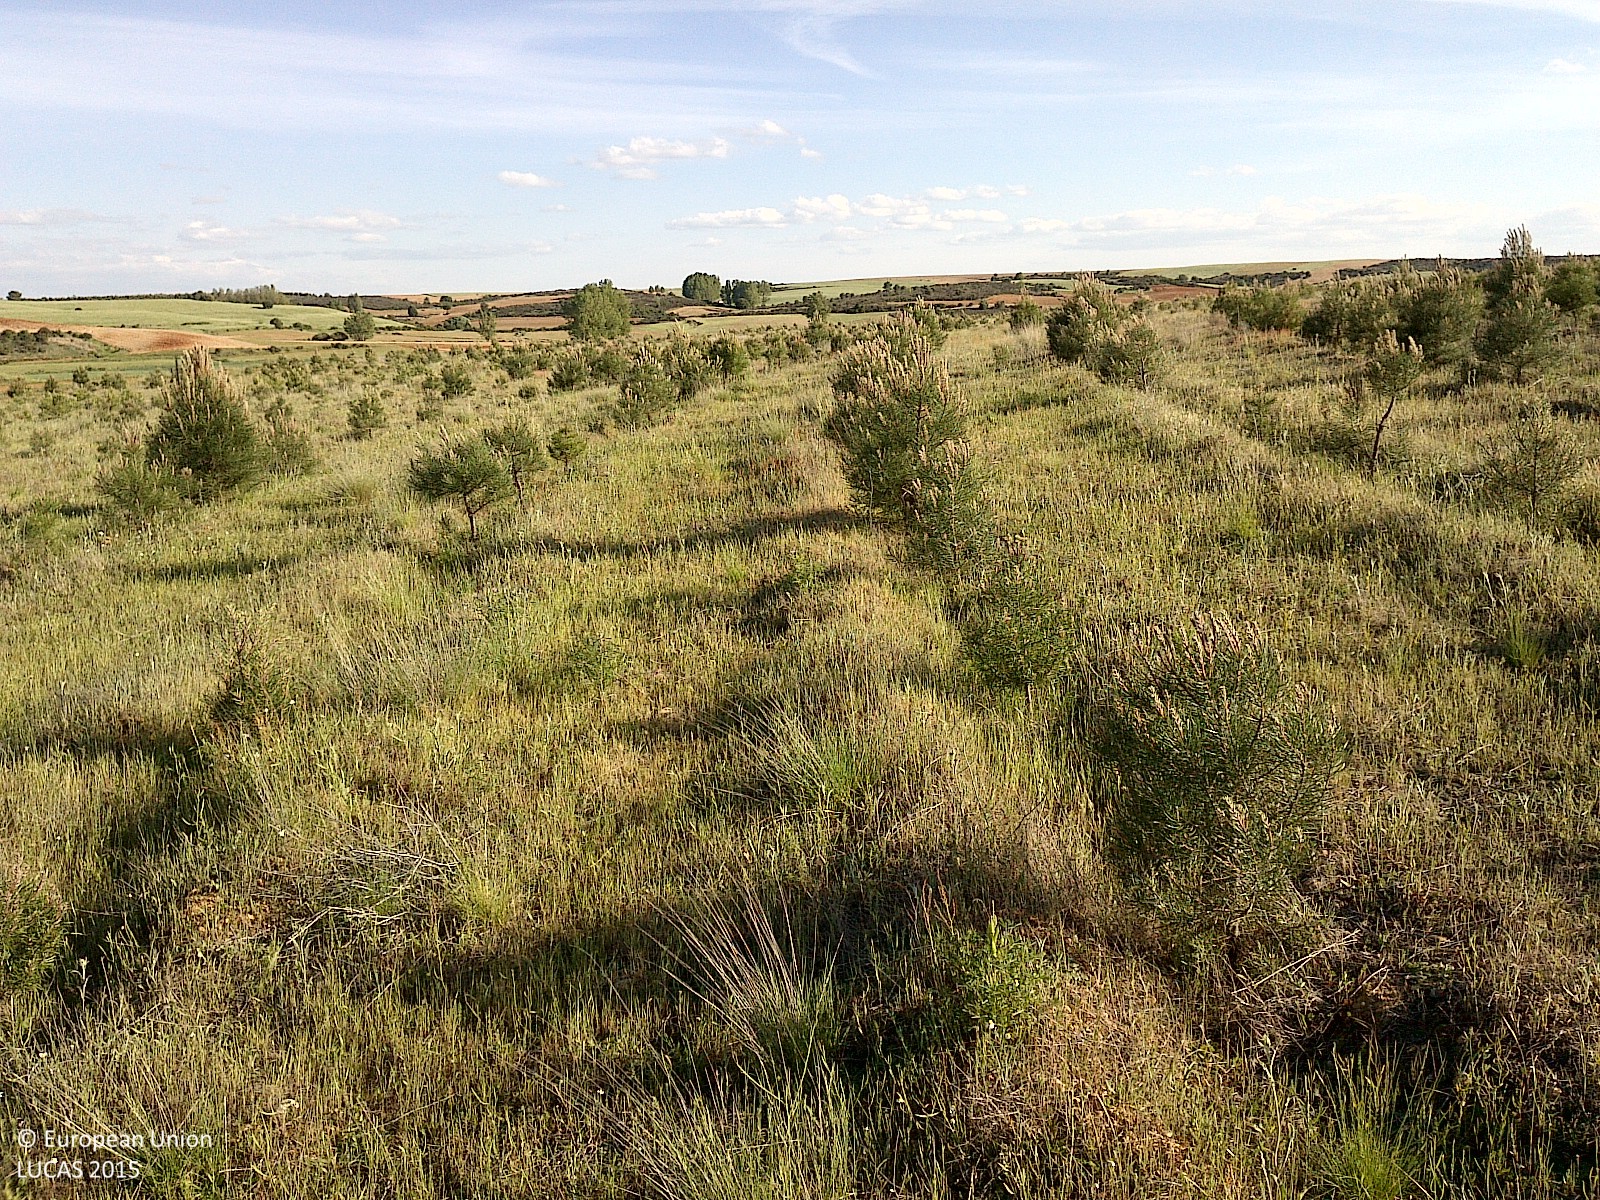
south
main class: Grassland
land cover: Grassland with sparse tree/shrub cover
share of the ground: > 75 %
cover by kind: herbaceous plants 95 %, coniferous forest trees 5 %
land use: Forestry
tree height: < 5 m
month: May
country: ES
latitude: 41.7213
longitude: -3.1360
